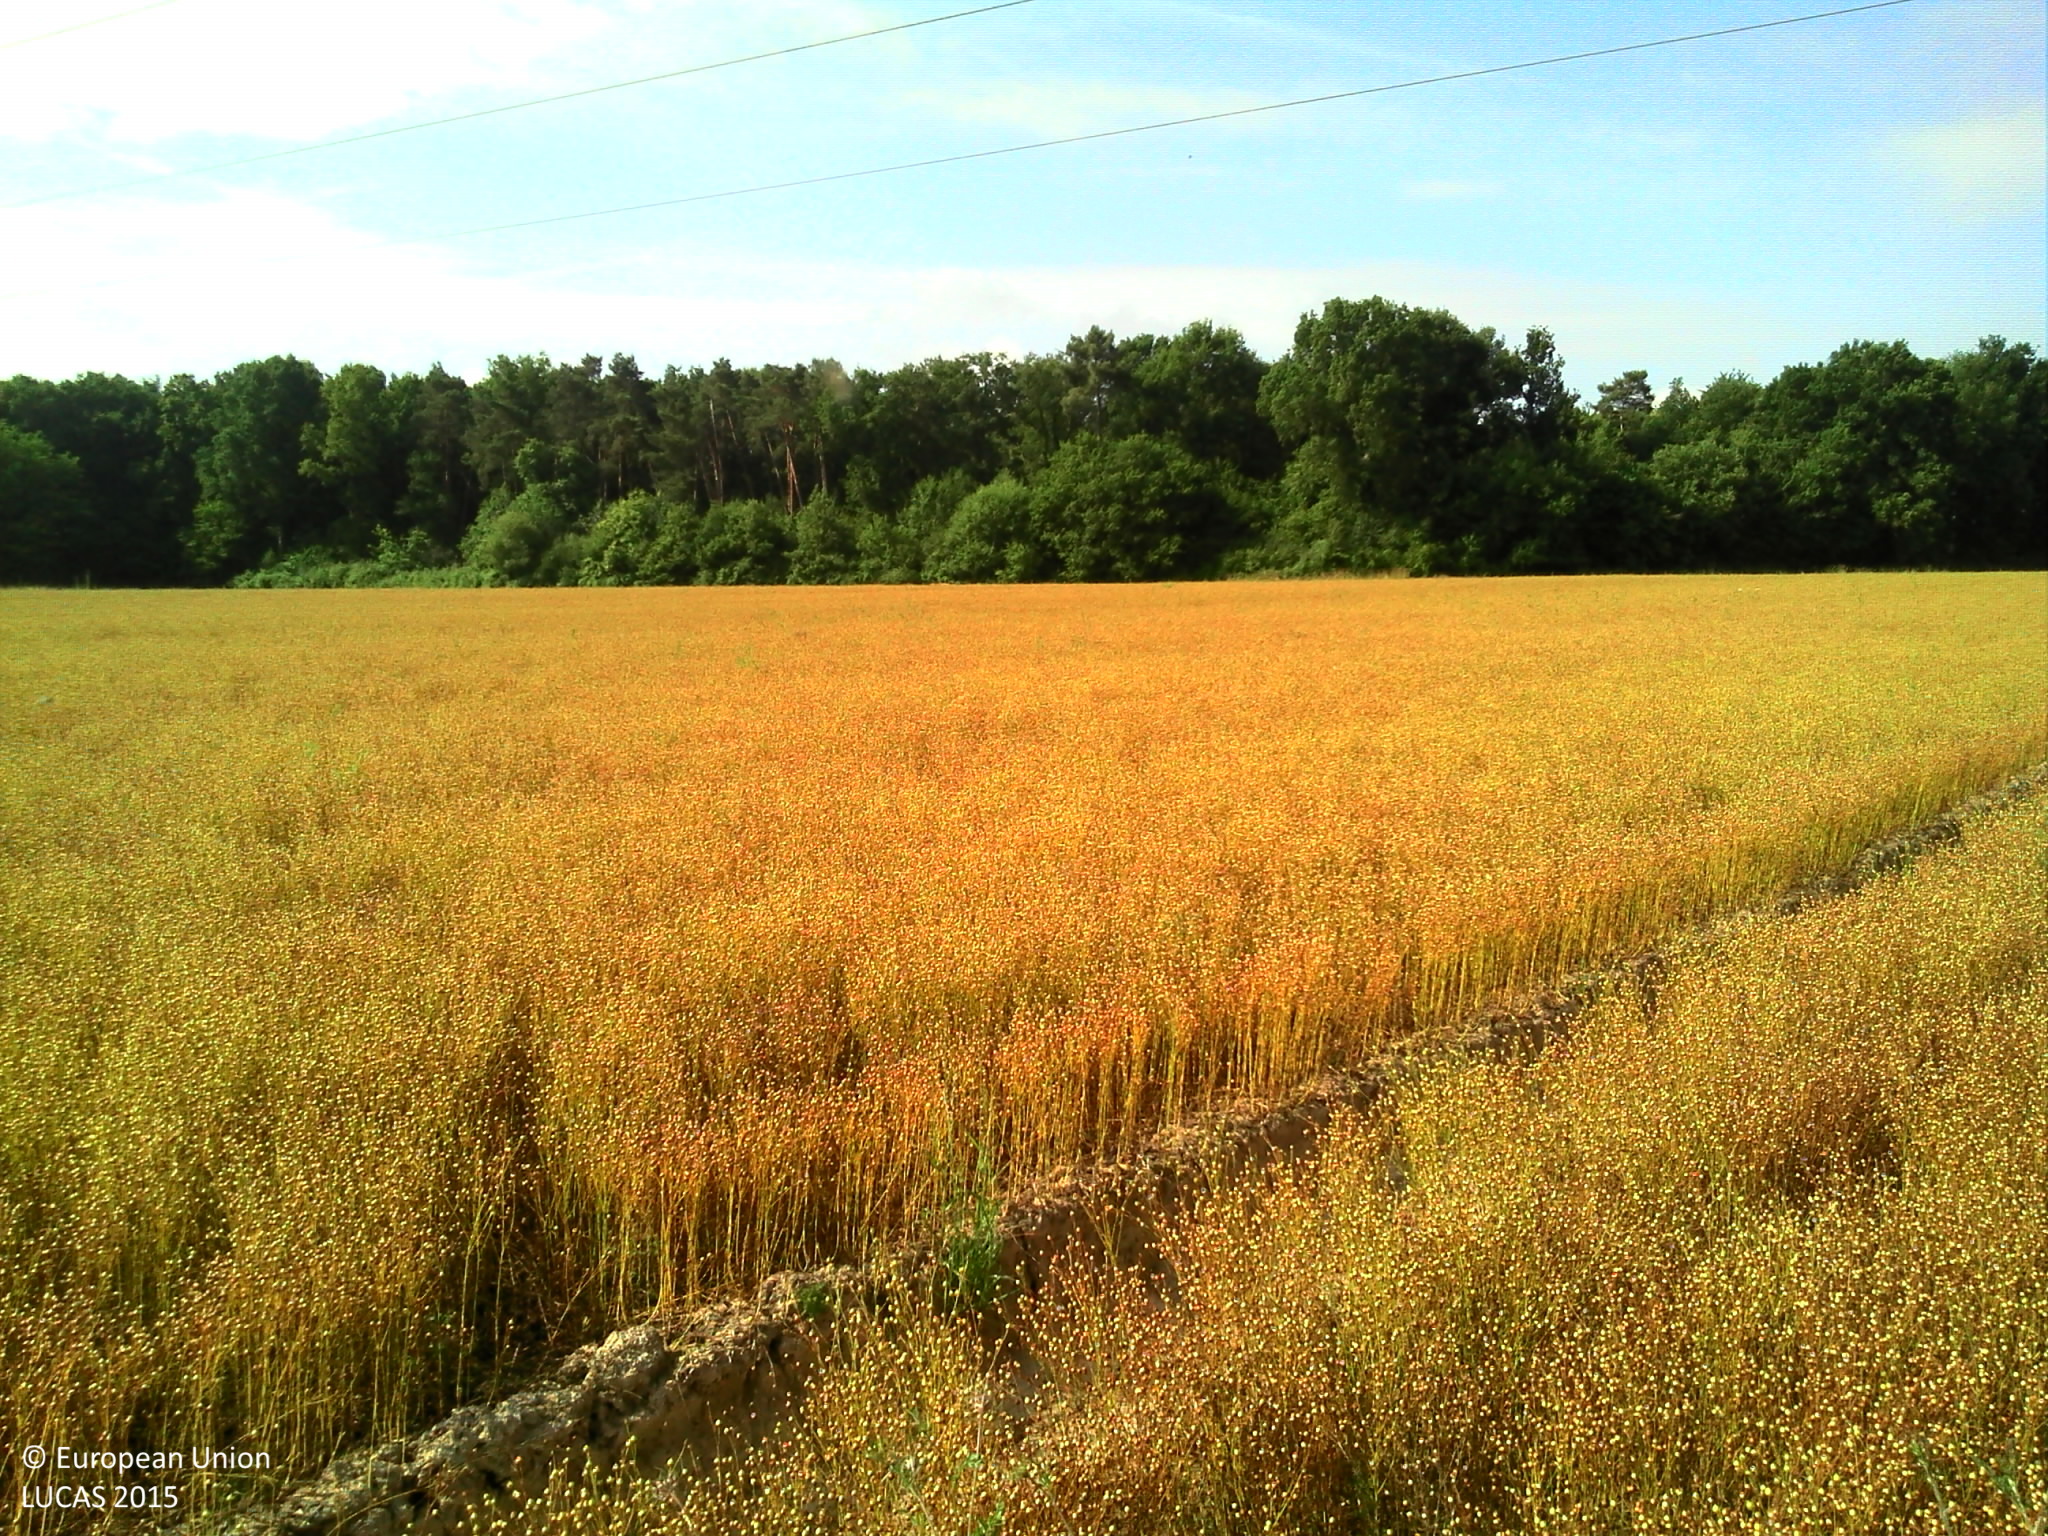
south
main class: Cropland
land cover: Other fibre and oleaginous crops
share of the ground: > 75 %
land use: Agriculture (excluding fallow land and kitchen gardens)
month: June
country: FR
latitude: 46.9055
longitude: 0.4892
